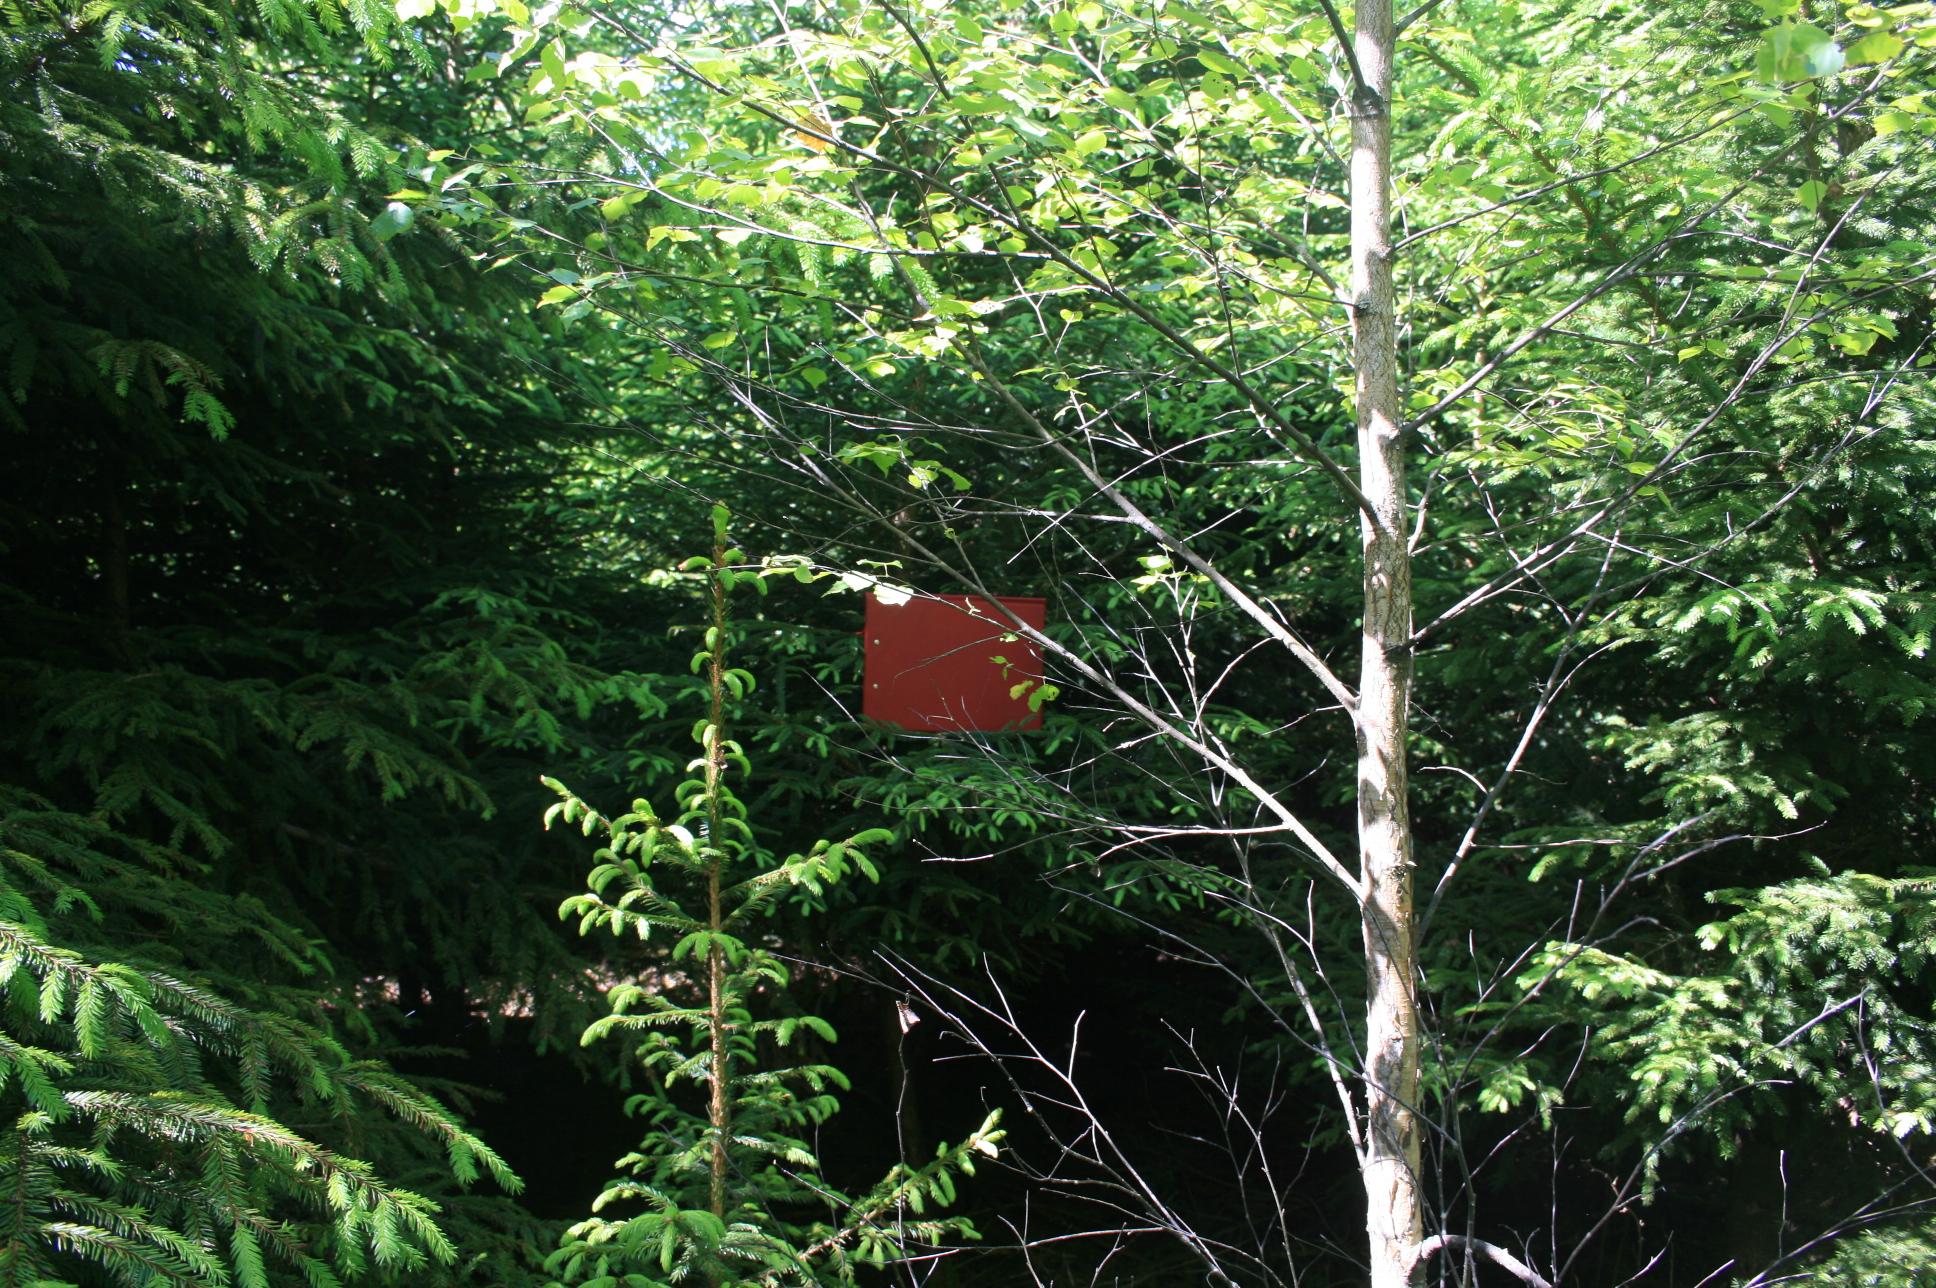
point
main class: Woodland
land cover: Spruce dominated coniferous woodland
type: hemiboreal forest and nemoral coniferous forest and mixed broadleaved-coniferous forest
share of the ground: > 75 %
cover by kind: coniferous forest trees 80 %, broadleaved forest trees 20 %
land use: Forestry
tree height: < 5 m
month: June
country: LT
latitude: 55.4587
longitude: 22.1855
